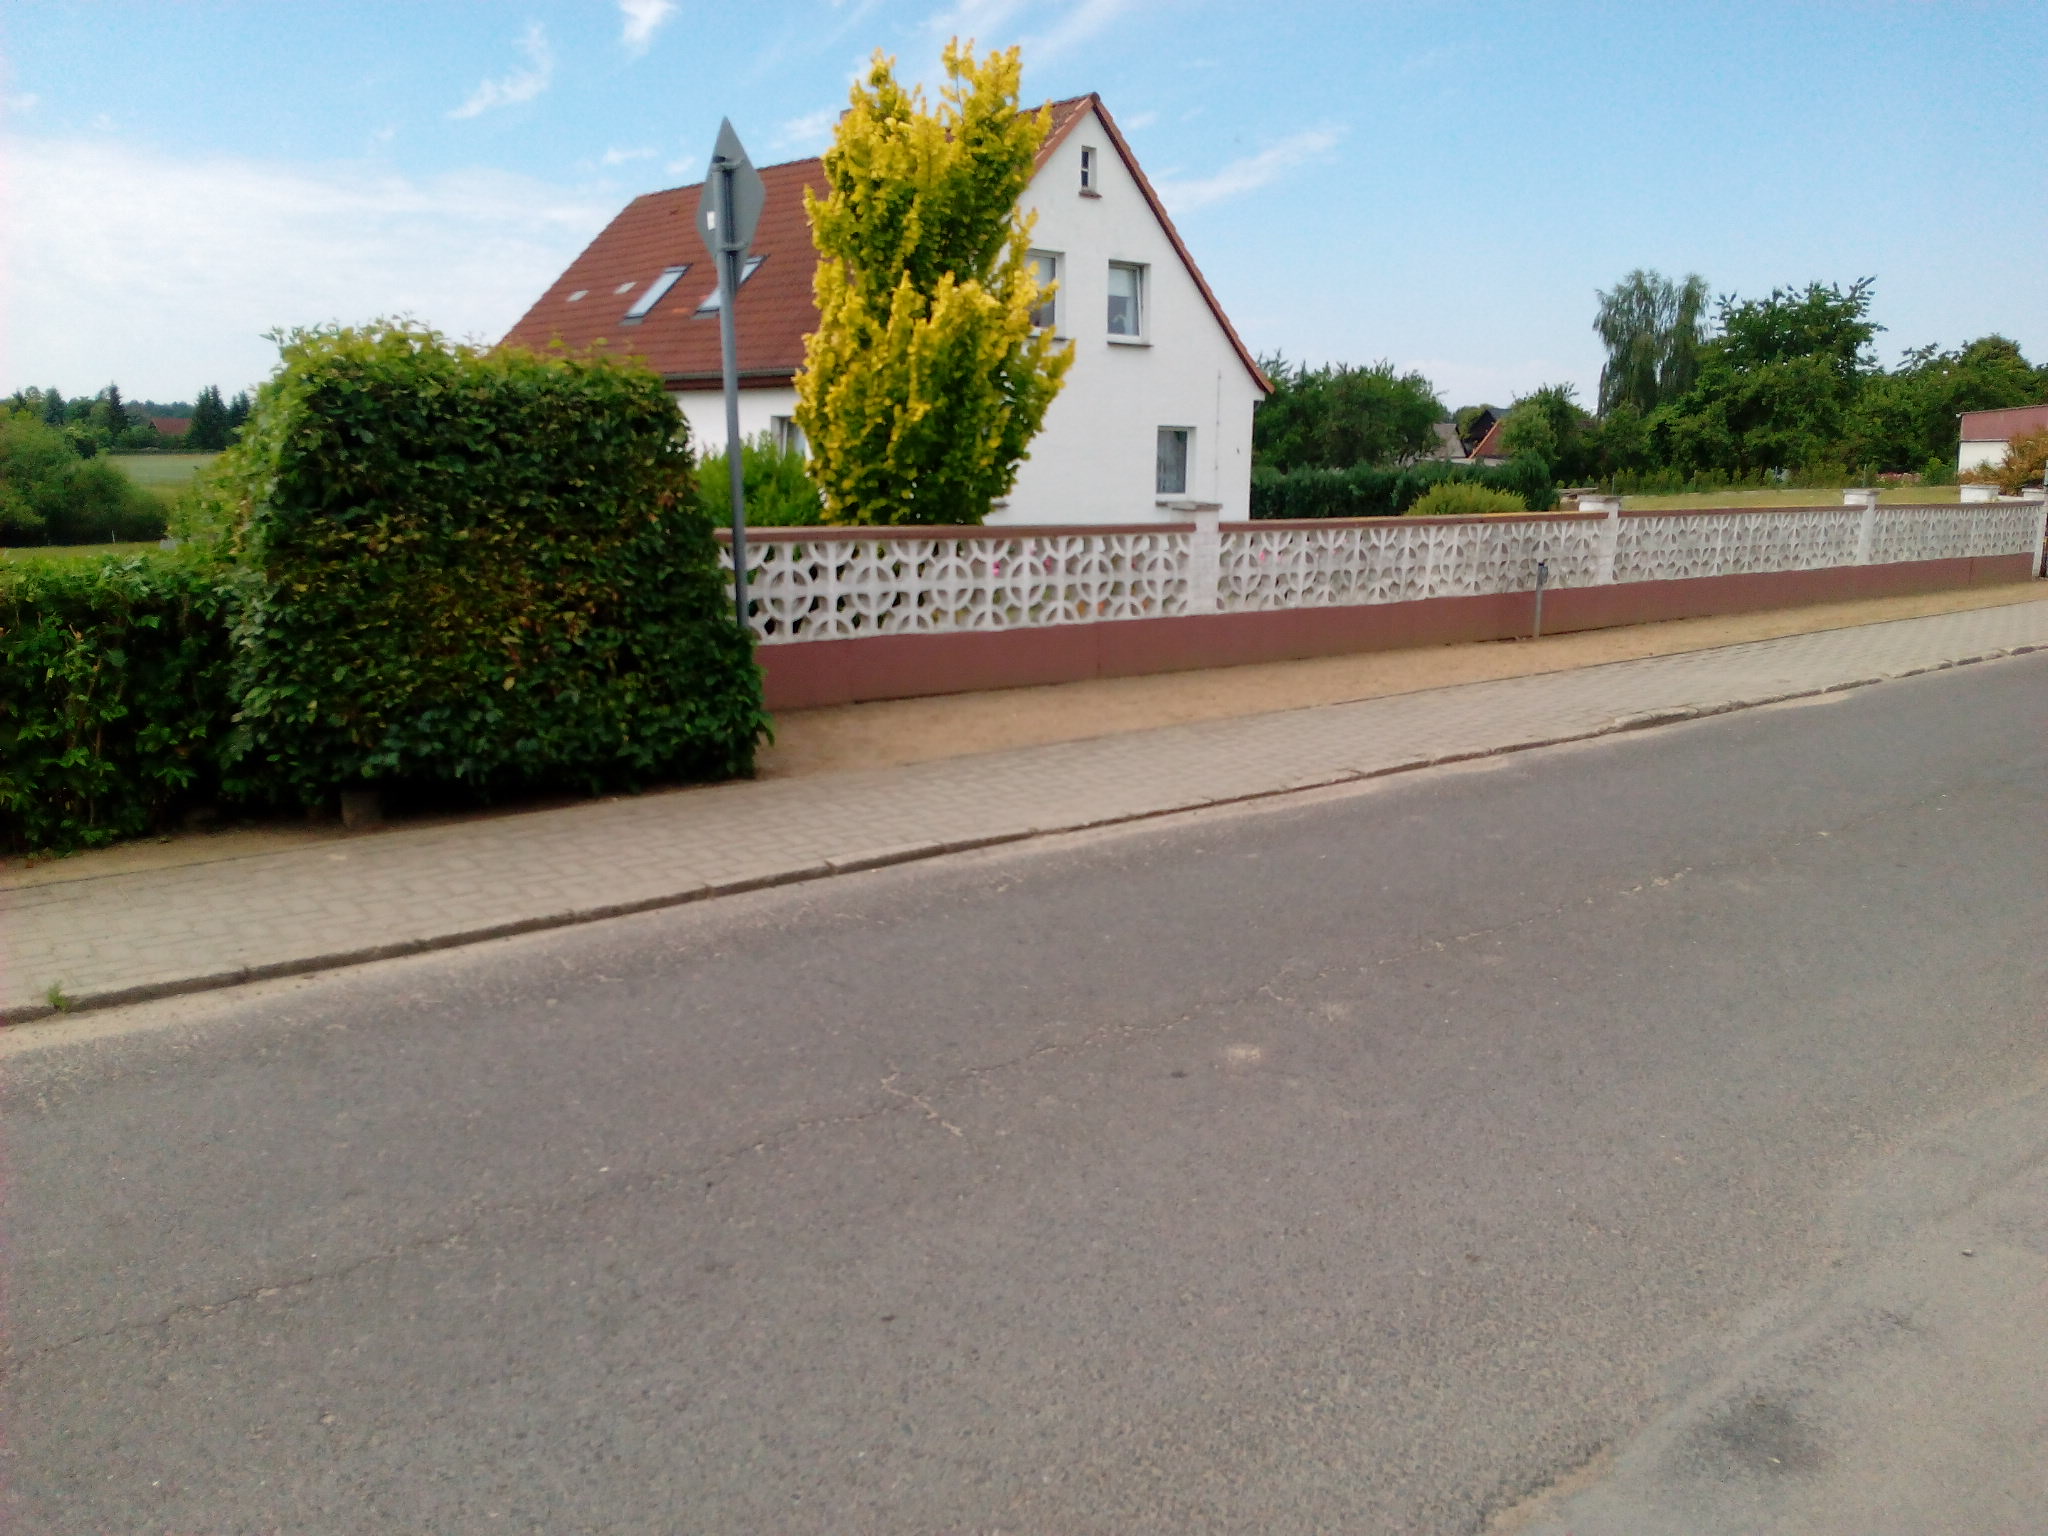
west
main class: Grassland
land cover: Grassland with sparse tree/shrub cover
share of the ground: > 75 %
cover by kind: herbaceous plants 80 %, consolidated bare surface 10 %, broadleaved forest trees 5 %, shrubs 5 %
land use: Residential
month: June
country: DE
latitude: 53.1846
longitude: 13.6664
